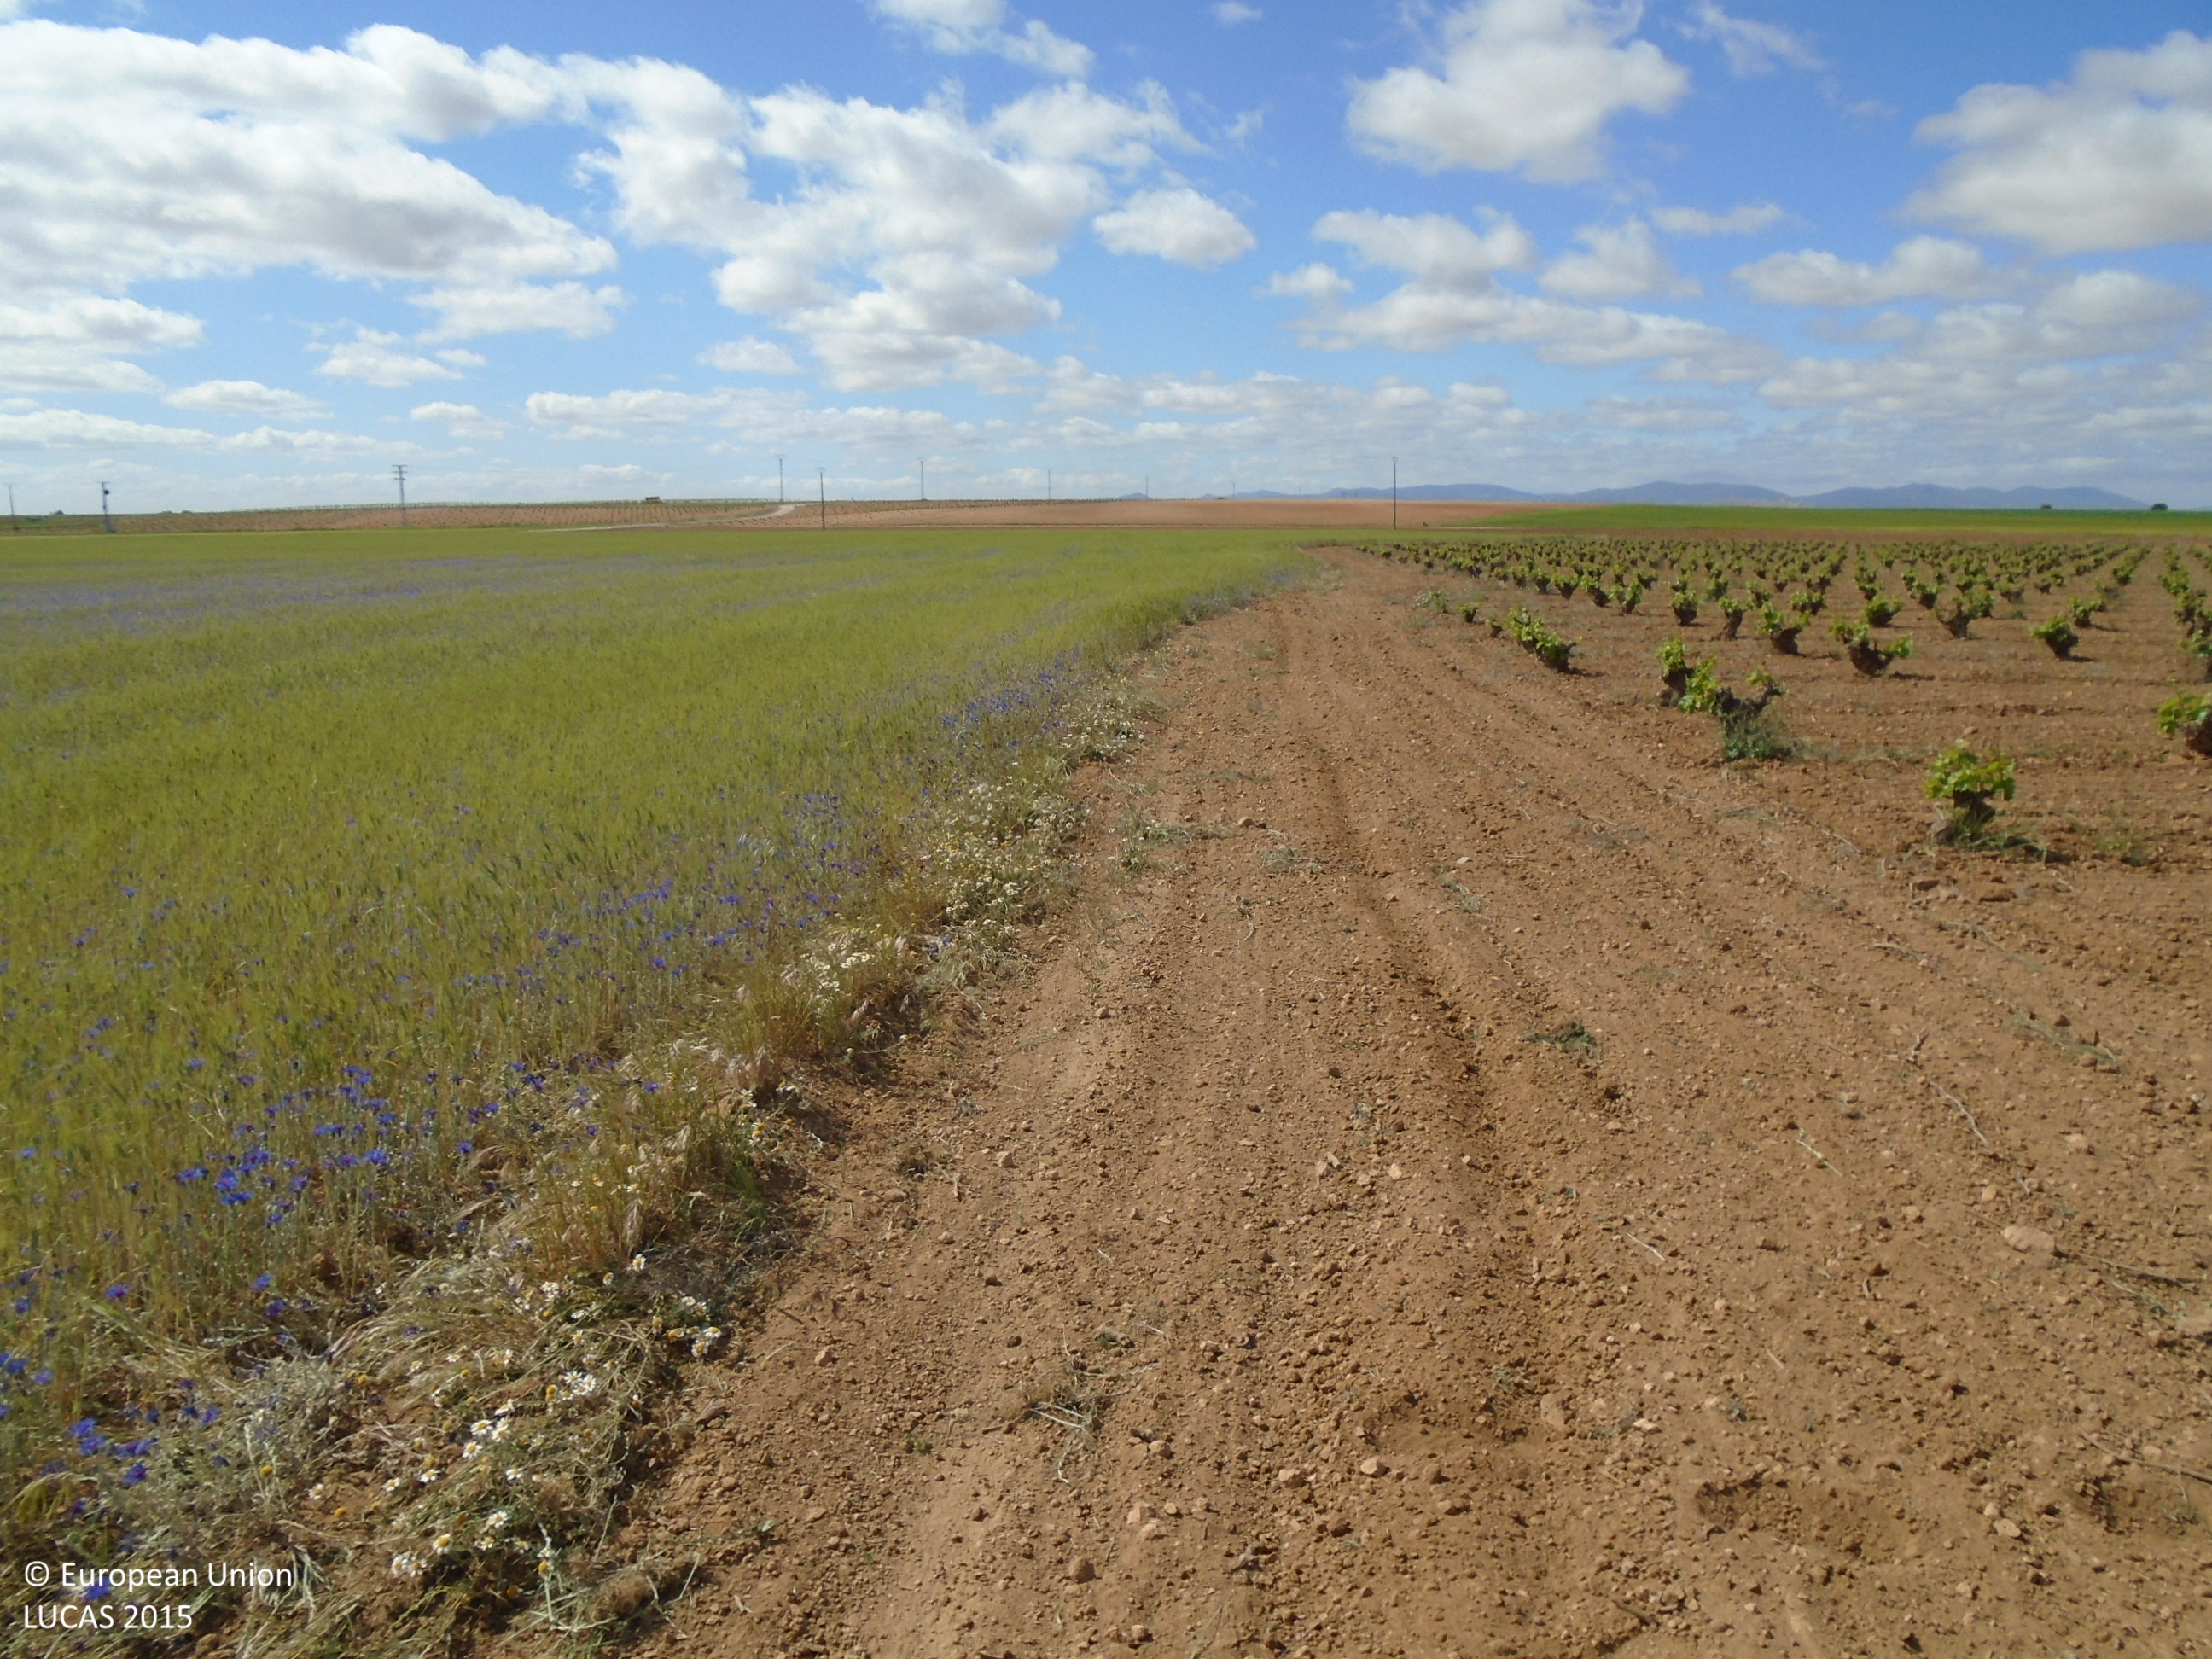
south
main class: Cropland
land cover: Vineyards
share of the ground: 10 - 25 %
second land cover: Other bare soil
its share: > 75 %
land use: Agriculture (excluding fallow land and kitchen gardens)
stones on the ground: < 10 %
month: May
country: ES
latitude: 39.5592
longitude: -3.5602
